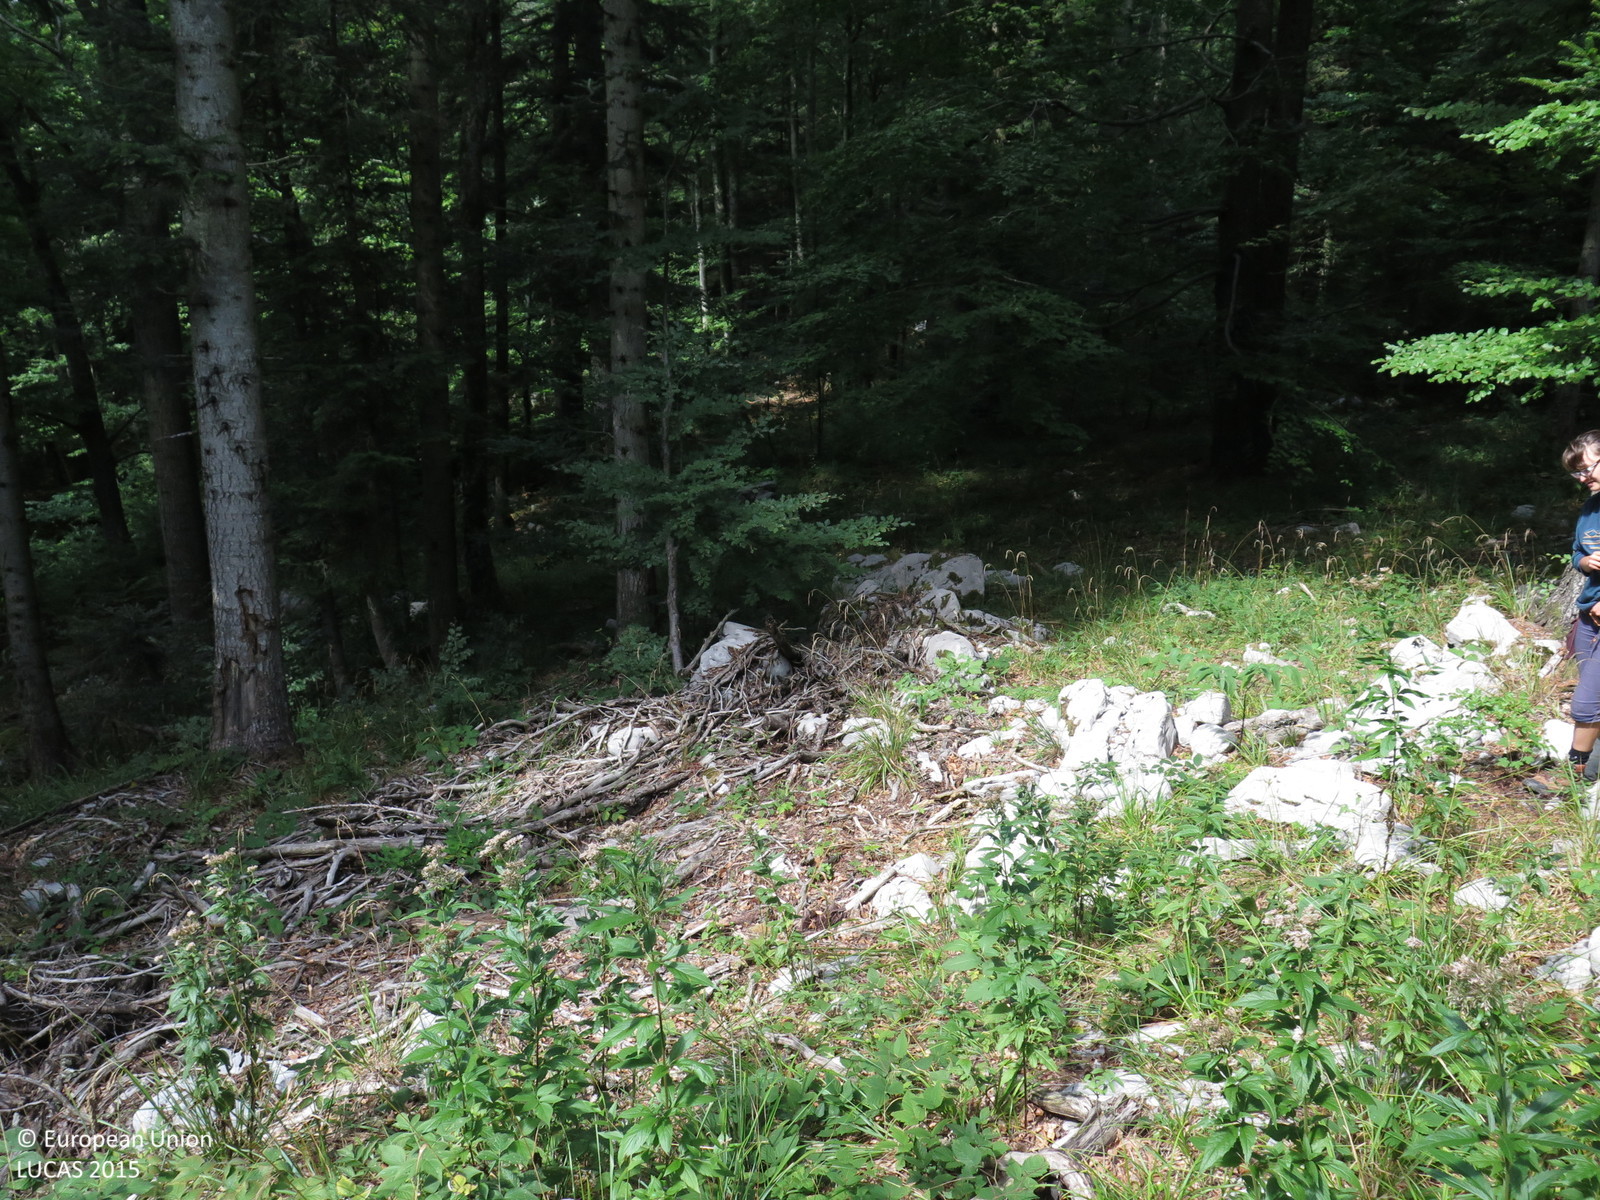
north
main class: Woodland
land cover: Other coniferous woodland
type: alpine coniferous forest
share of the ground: > 75 %
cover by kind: coniferous forest trees 75 %, broadleaved forest trees 25 %
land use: Forestry
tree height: > 5 m
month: August
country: HR
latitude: 45.1528
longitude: 14.9682
